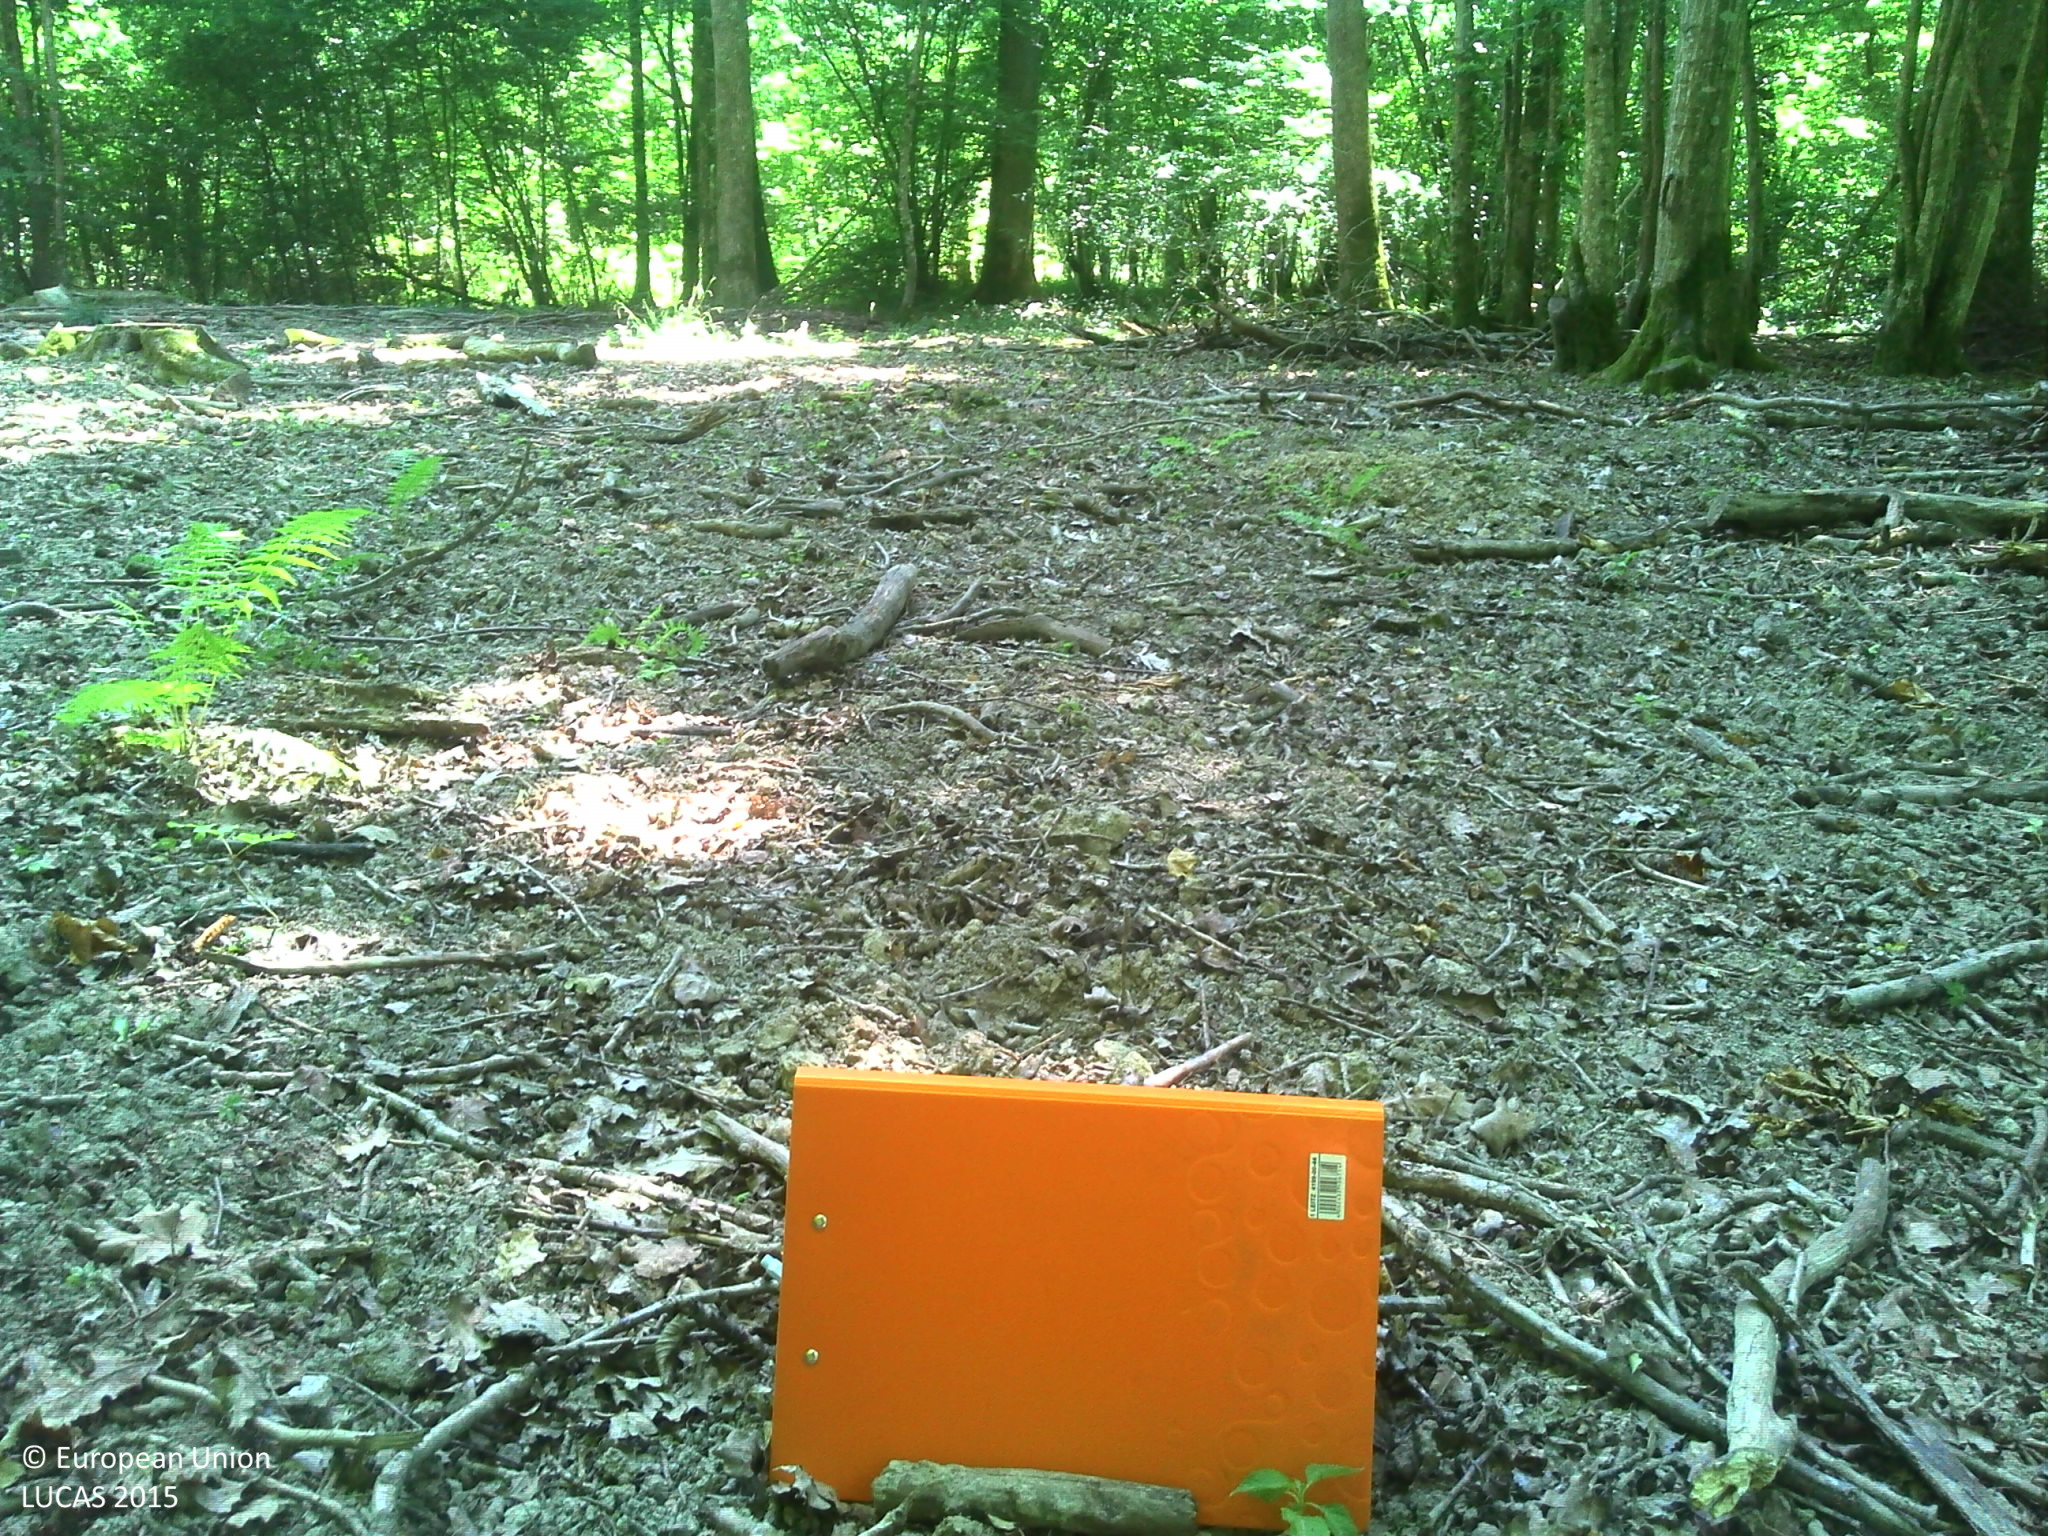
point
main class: Woodland
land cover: Broadleaved woodland
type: mesophytic deciduous forest
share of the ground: > 75 %
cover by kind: broadleaved forest trees 90 %, herbaceous plants 5 %, consolidated bare surface 5 %
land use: Forestry
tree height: > 5 m
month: June
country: FR
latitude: 48.9283
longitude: 3.4004
